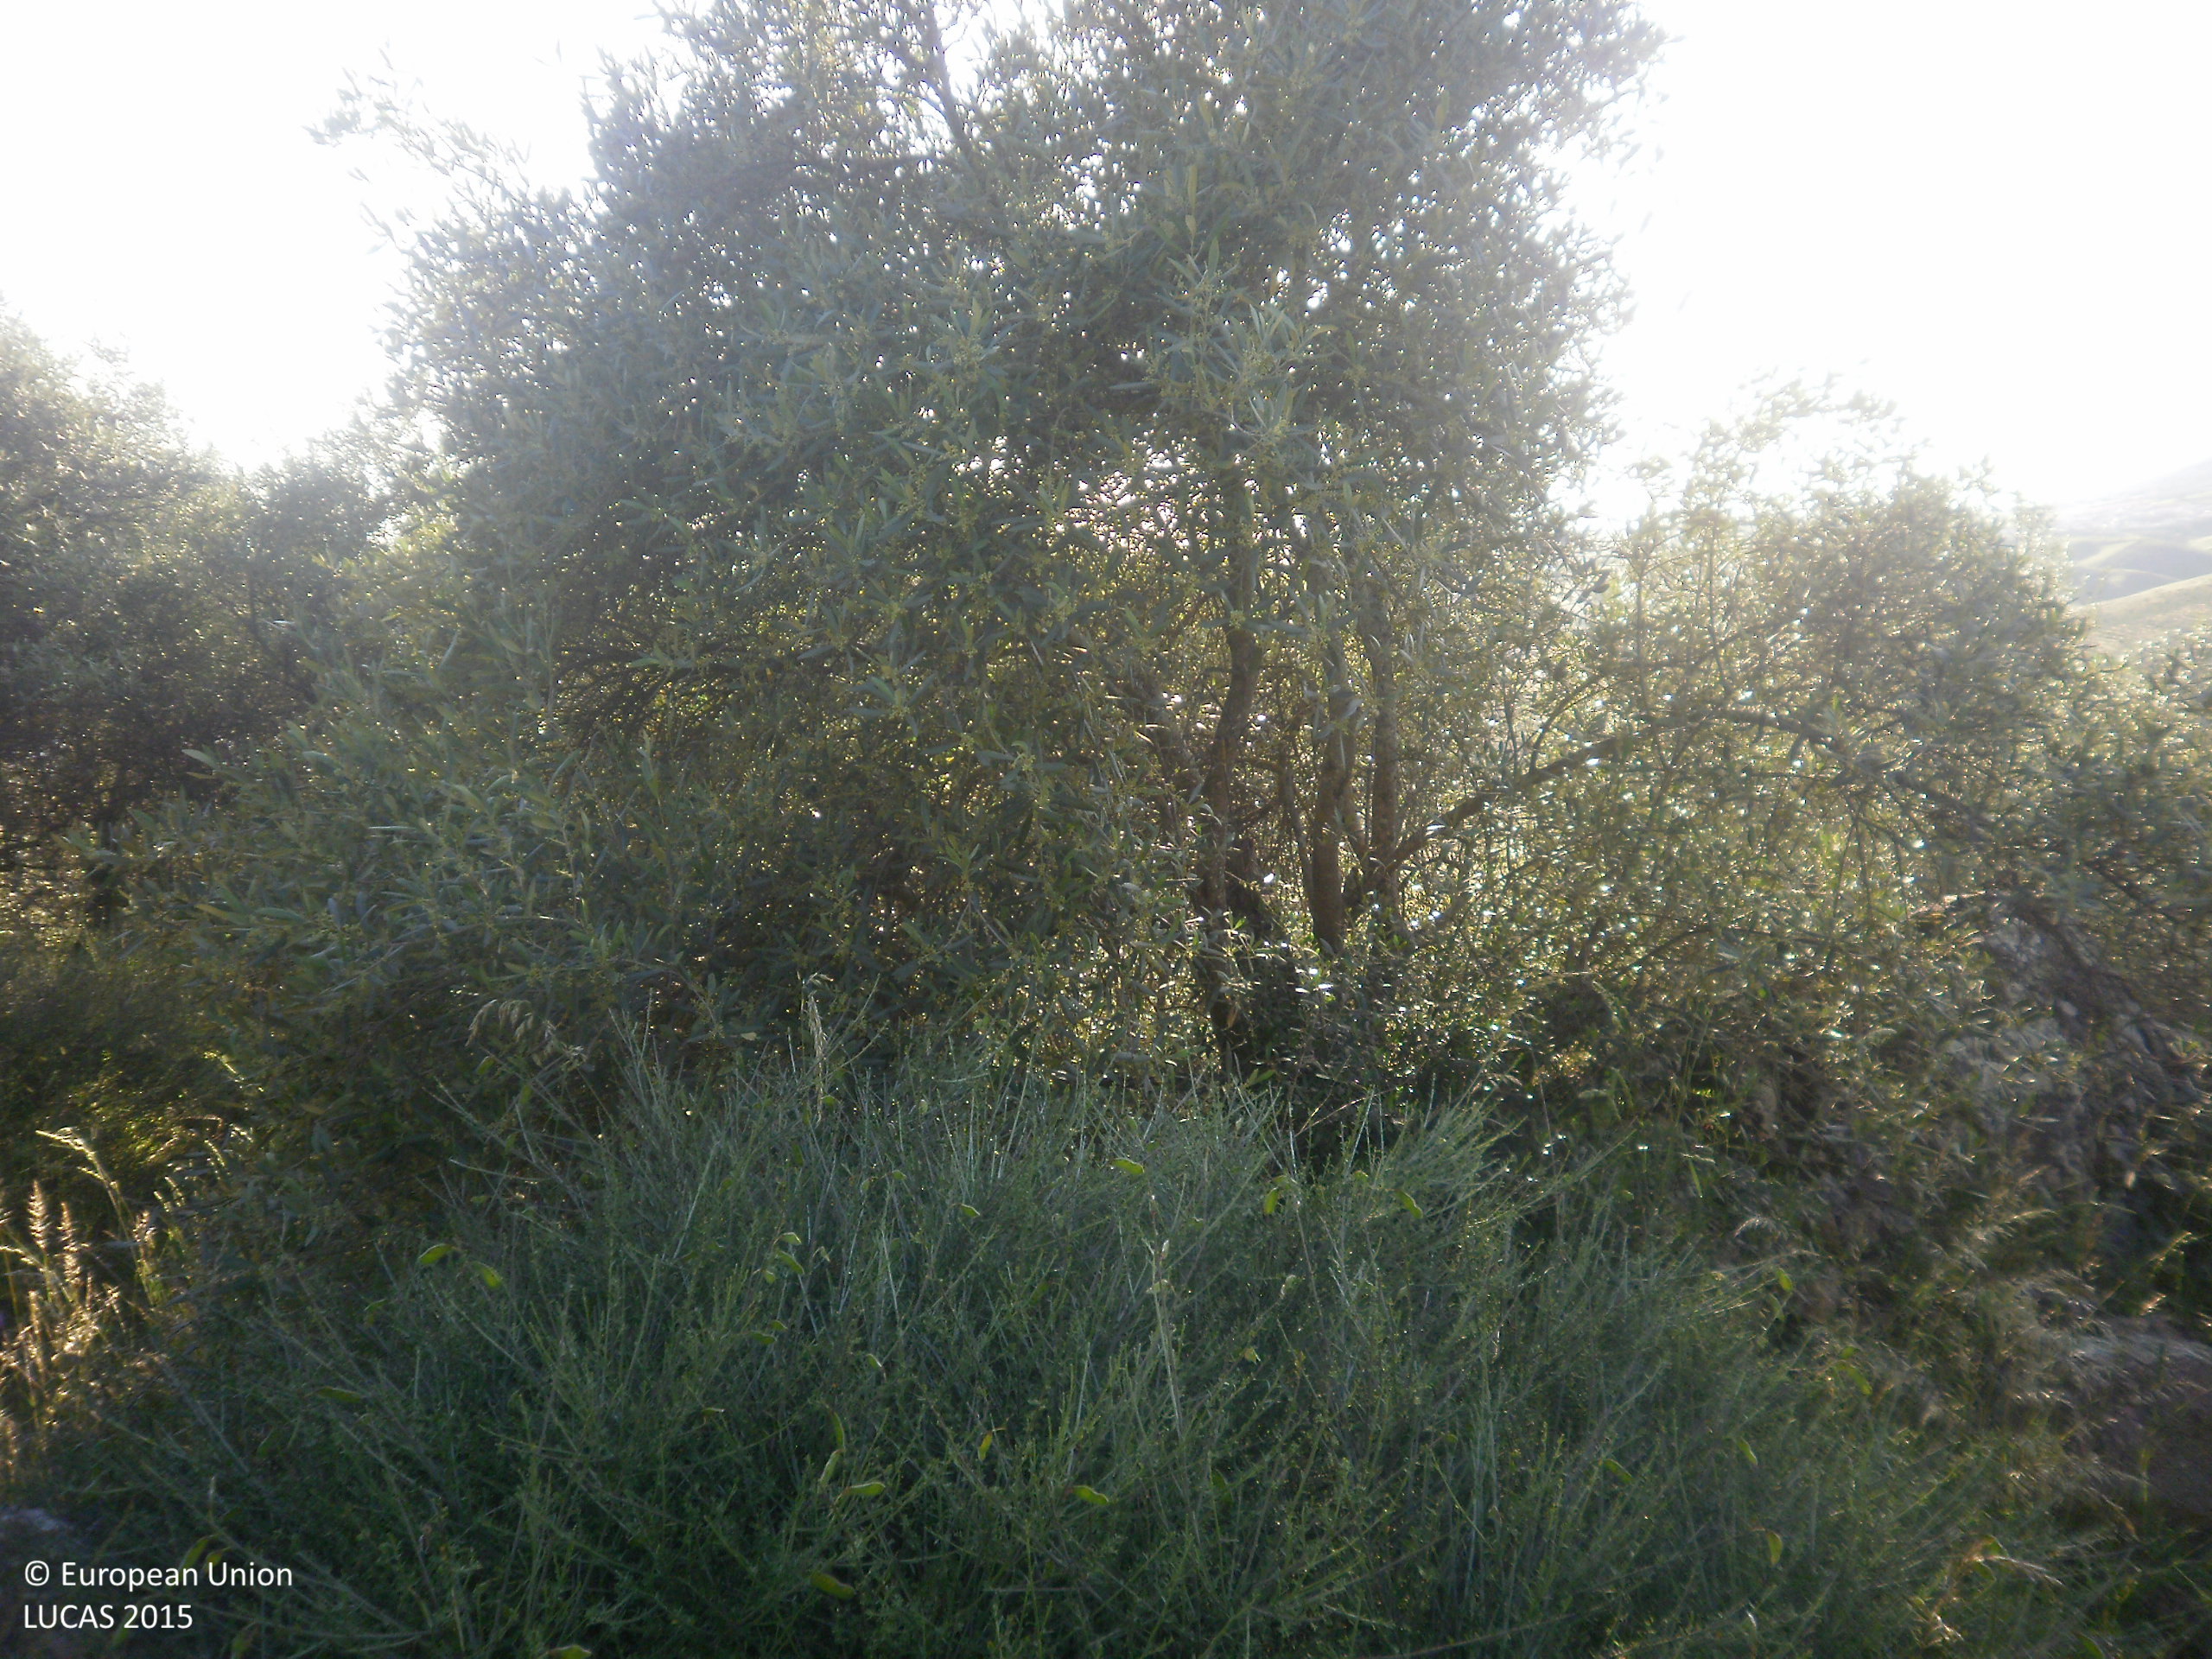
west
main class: Grassland
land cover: Grassland with sparse tree/shrub cover
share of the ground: > 75 %
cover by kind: herbaceous plants 90 %, broadleaved forest trees 5 %, shrubs 5 %
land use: Agriculture (excluding fallow land and kitchen gardens)
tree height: > 5 m
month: April
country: ES
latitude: 38.9591
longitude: -5.2370
